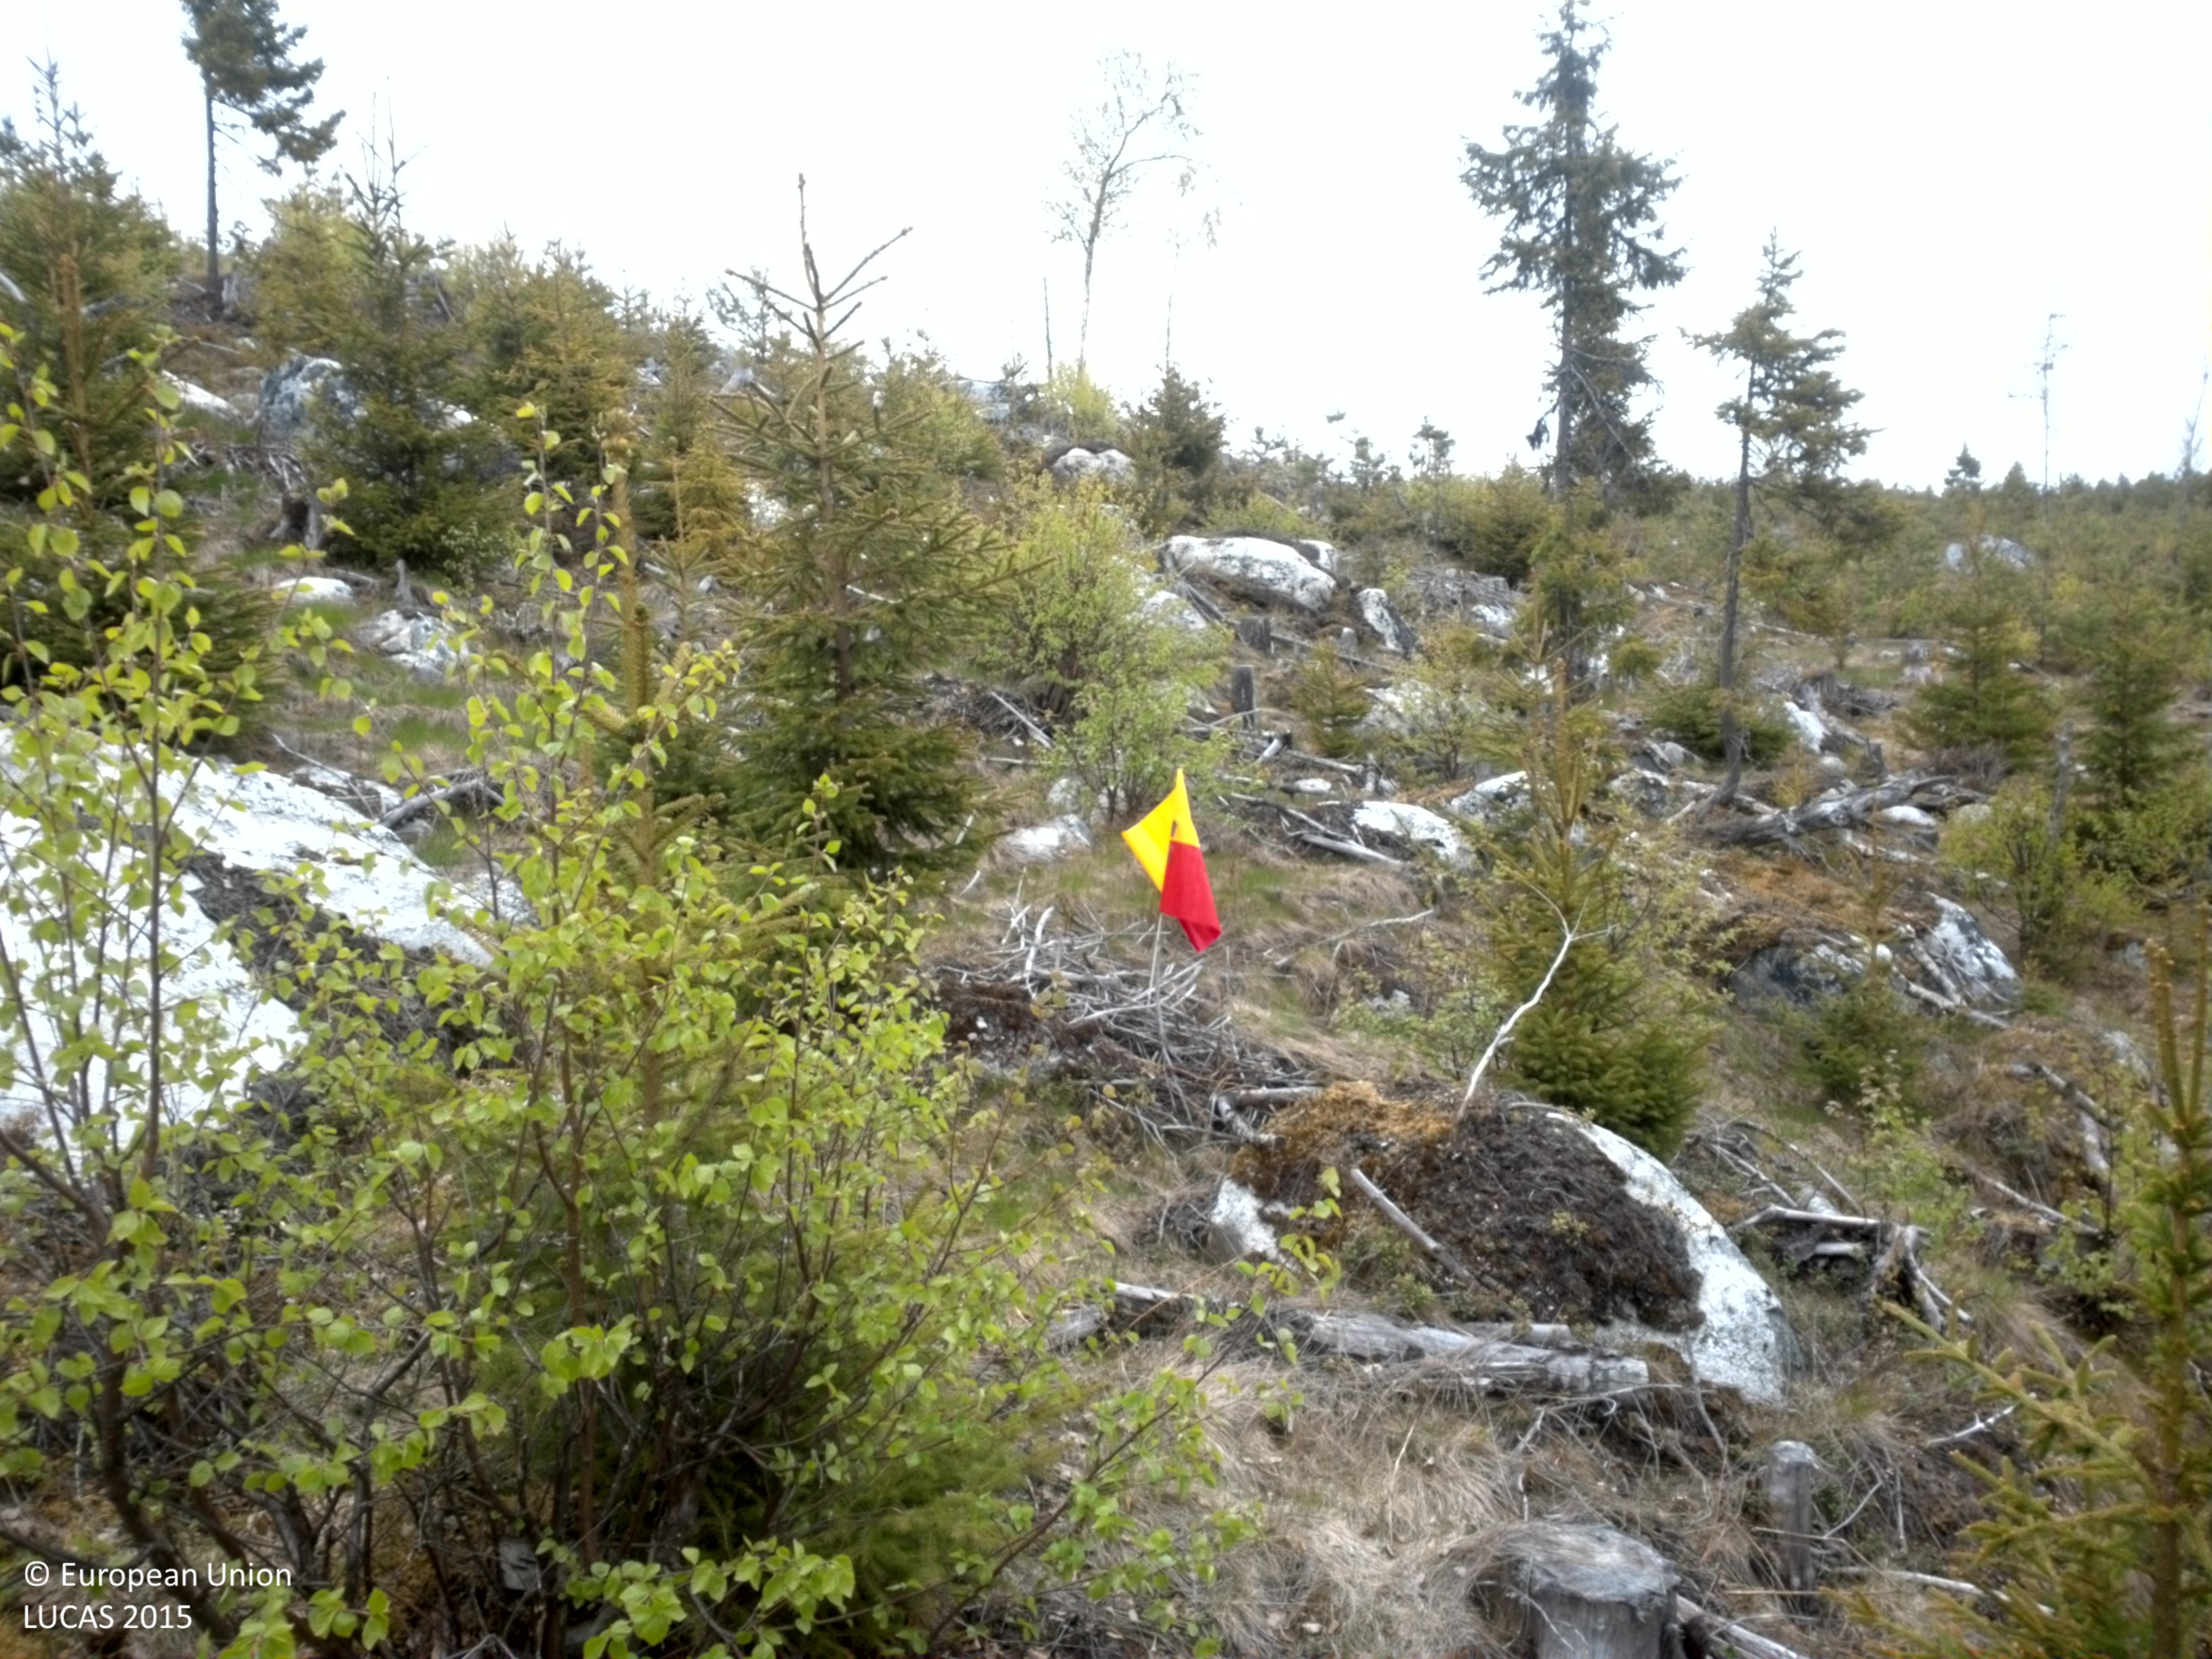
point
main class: Woodland
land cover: Spruce dominated coniferous woodland
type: boreal forest
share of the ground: 25 - 50 %
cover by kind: herbaceous plants 35 %, coniferous forest trees 30 %, unconsolidated bare surface 20 %, broadleaved forest trees 5 %, shrubs 5 %, lichens and mosses 5 %
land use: Forestry
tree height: < 5 m
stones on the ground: 25 - 50 %
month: June
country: SE
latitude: 64.3146
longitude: 17.4334
